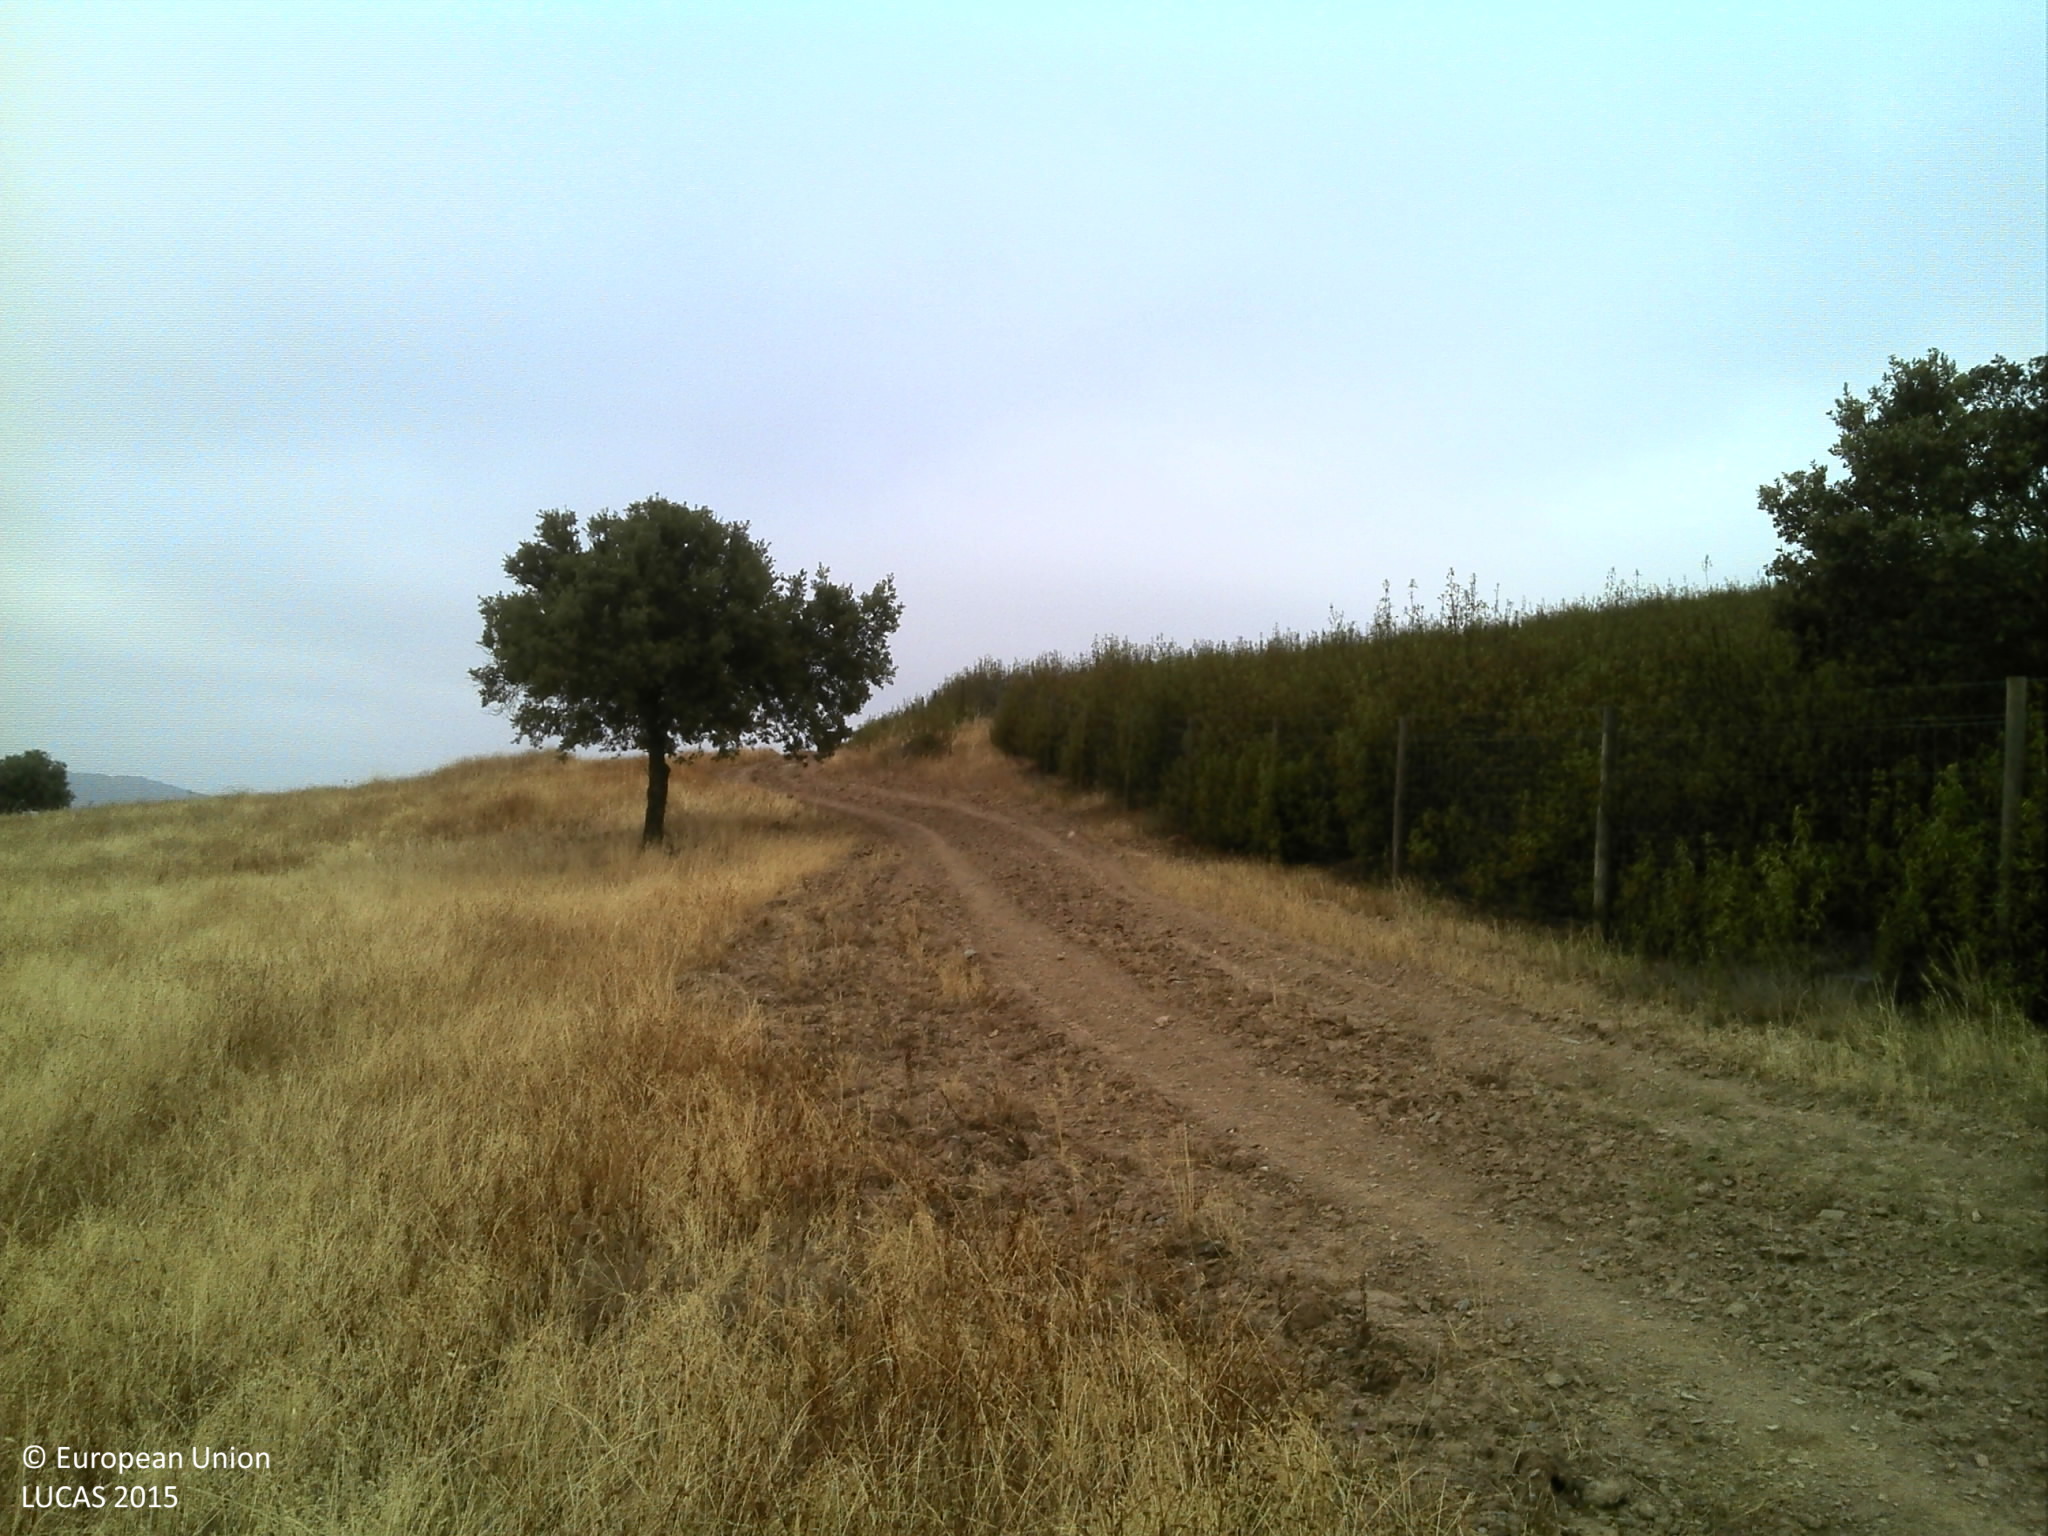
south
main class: Grassland
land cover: Grassland without tree/shrub cover
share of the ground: > 75 %
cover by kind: herbaceous plants 80 %, unconsolidated bare surface 20 %
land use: Agriculture (excluding fallow land and kitchen gardens)
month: July
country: PT
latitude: 38.4747
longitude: -7.4146
